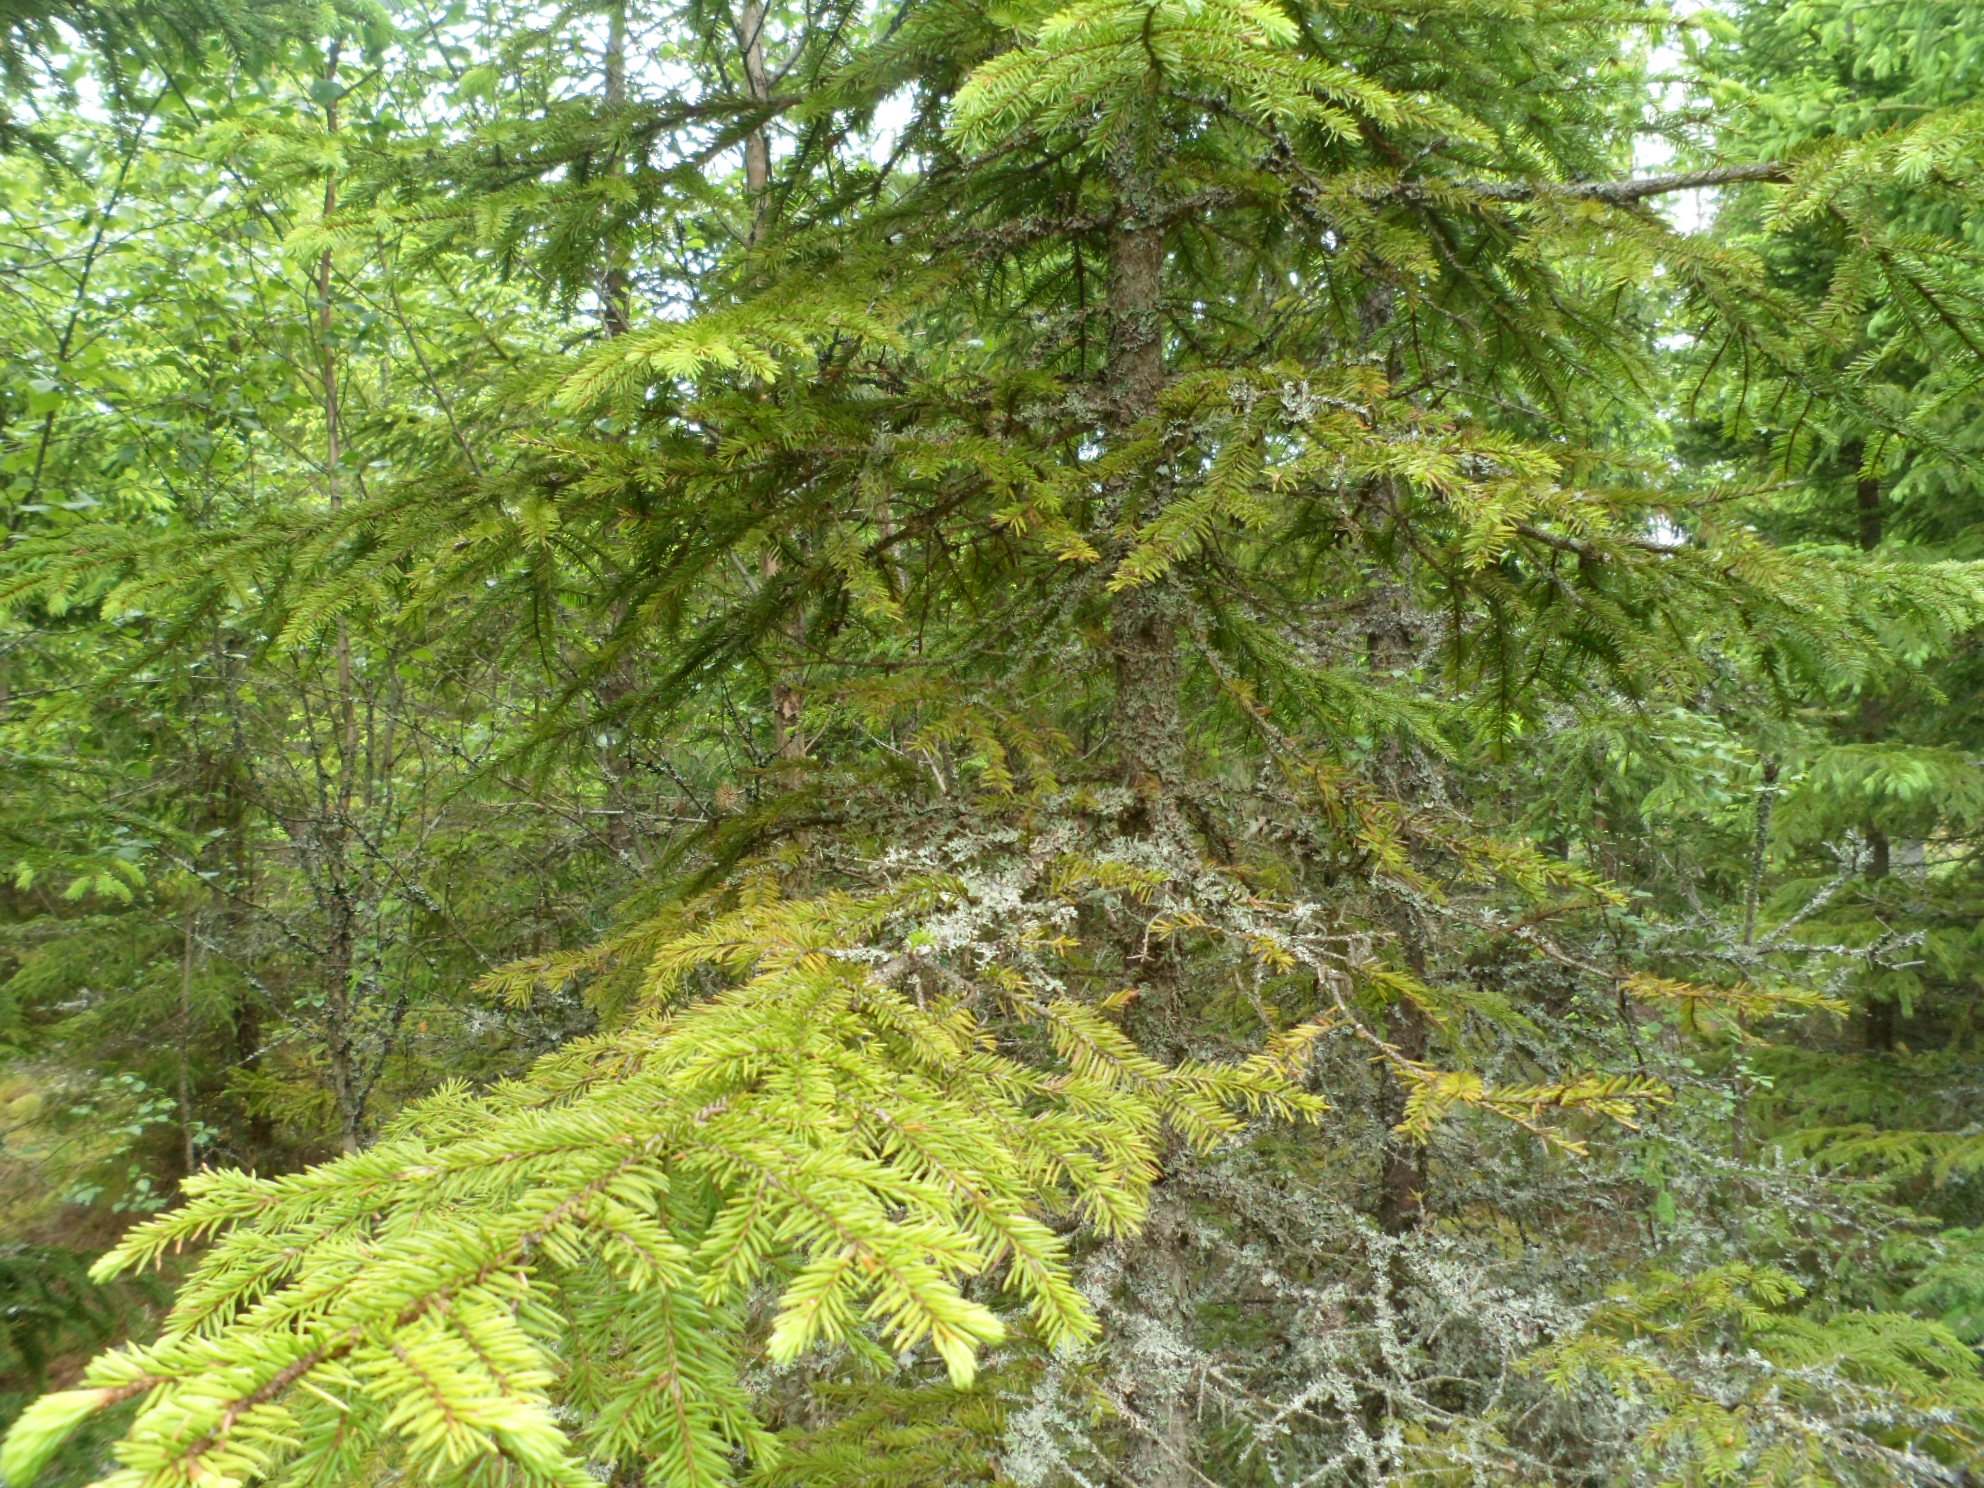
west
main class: Woodland
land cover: Spruce dominated coniferous woodland
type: boreal forest
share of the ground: > 75 %
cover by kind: coniferous forest trees 75 %, shrubs 10 %, lichens and mosses 10 %, herbaceous plants 5 %
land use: Forestry
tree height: > 5 m
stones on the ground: 25 - 50 %
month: June
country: SE
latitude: 57.0878
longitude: 15.2944
